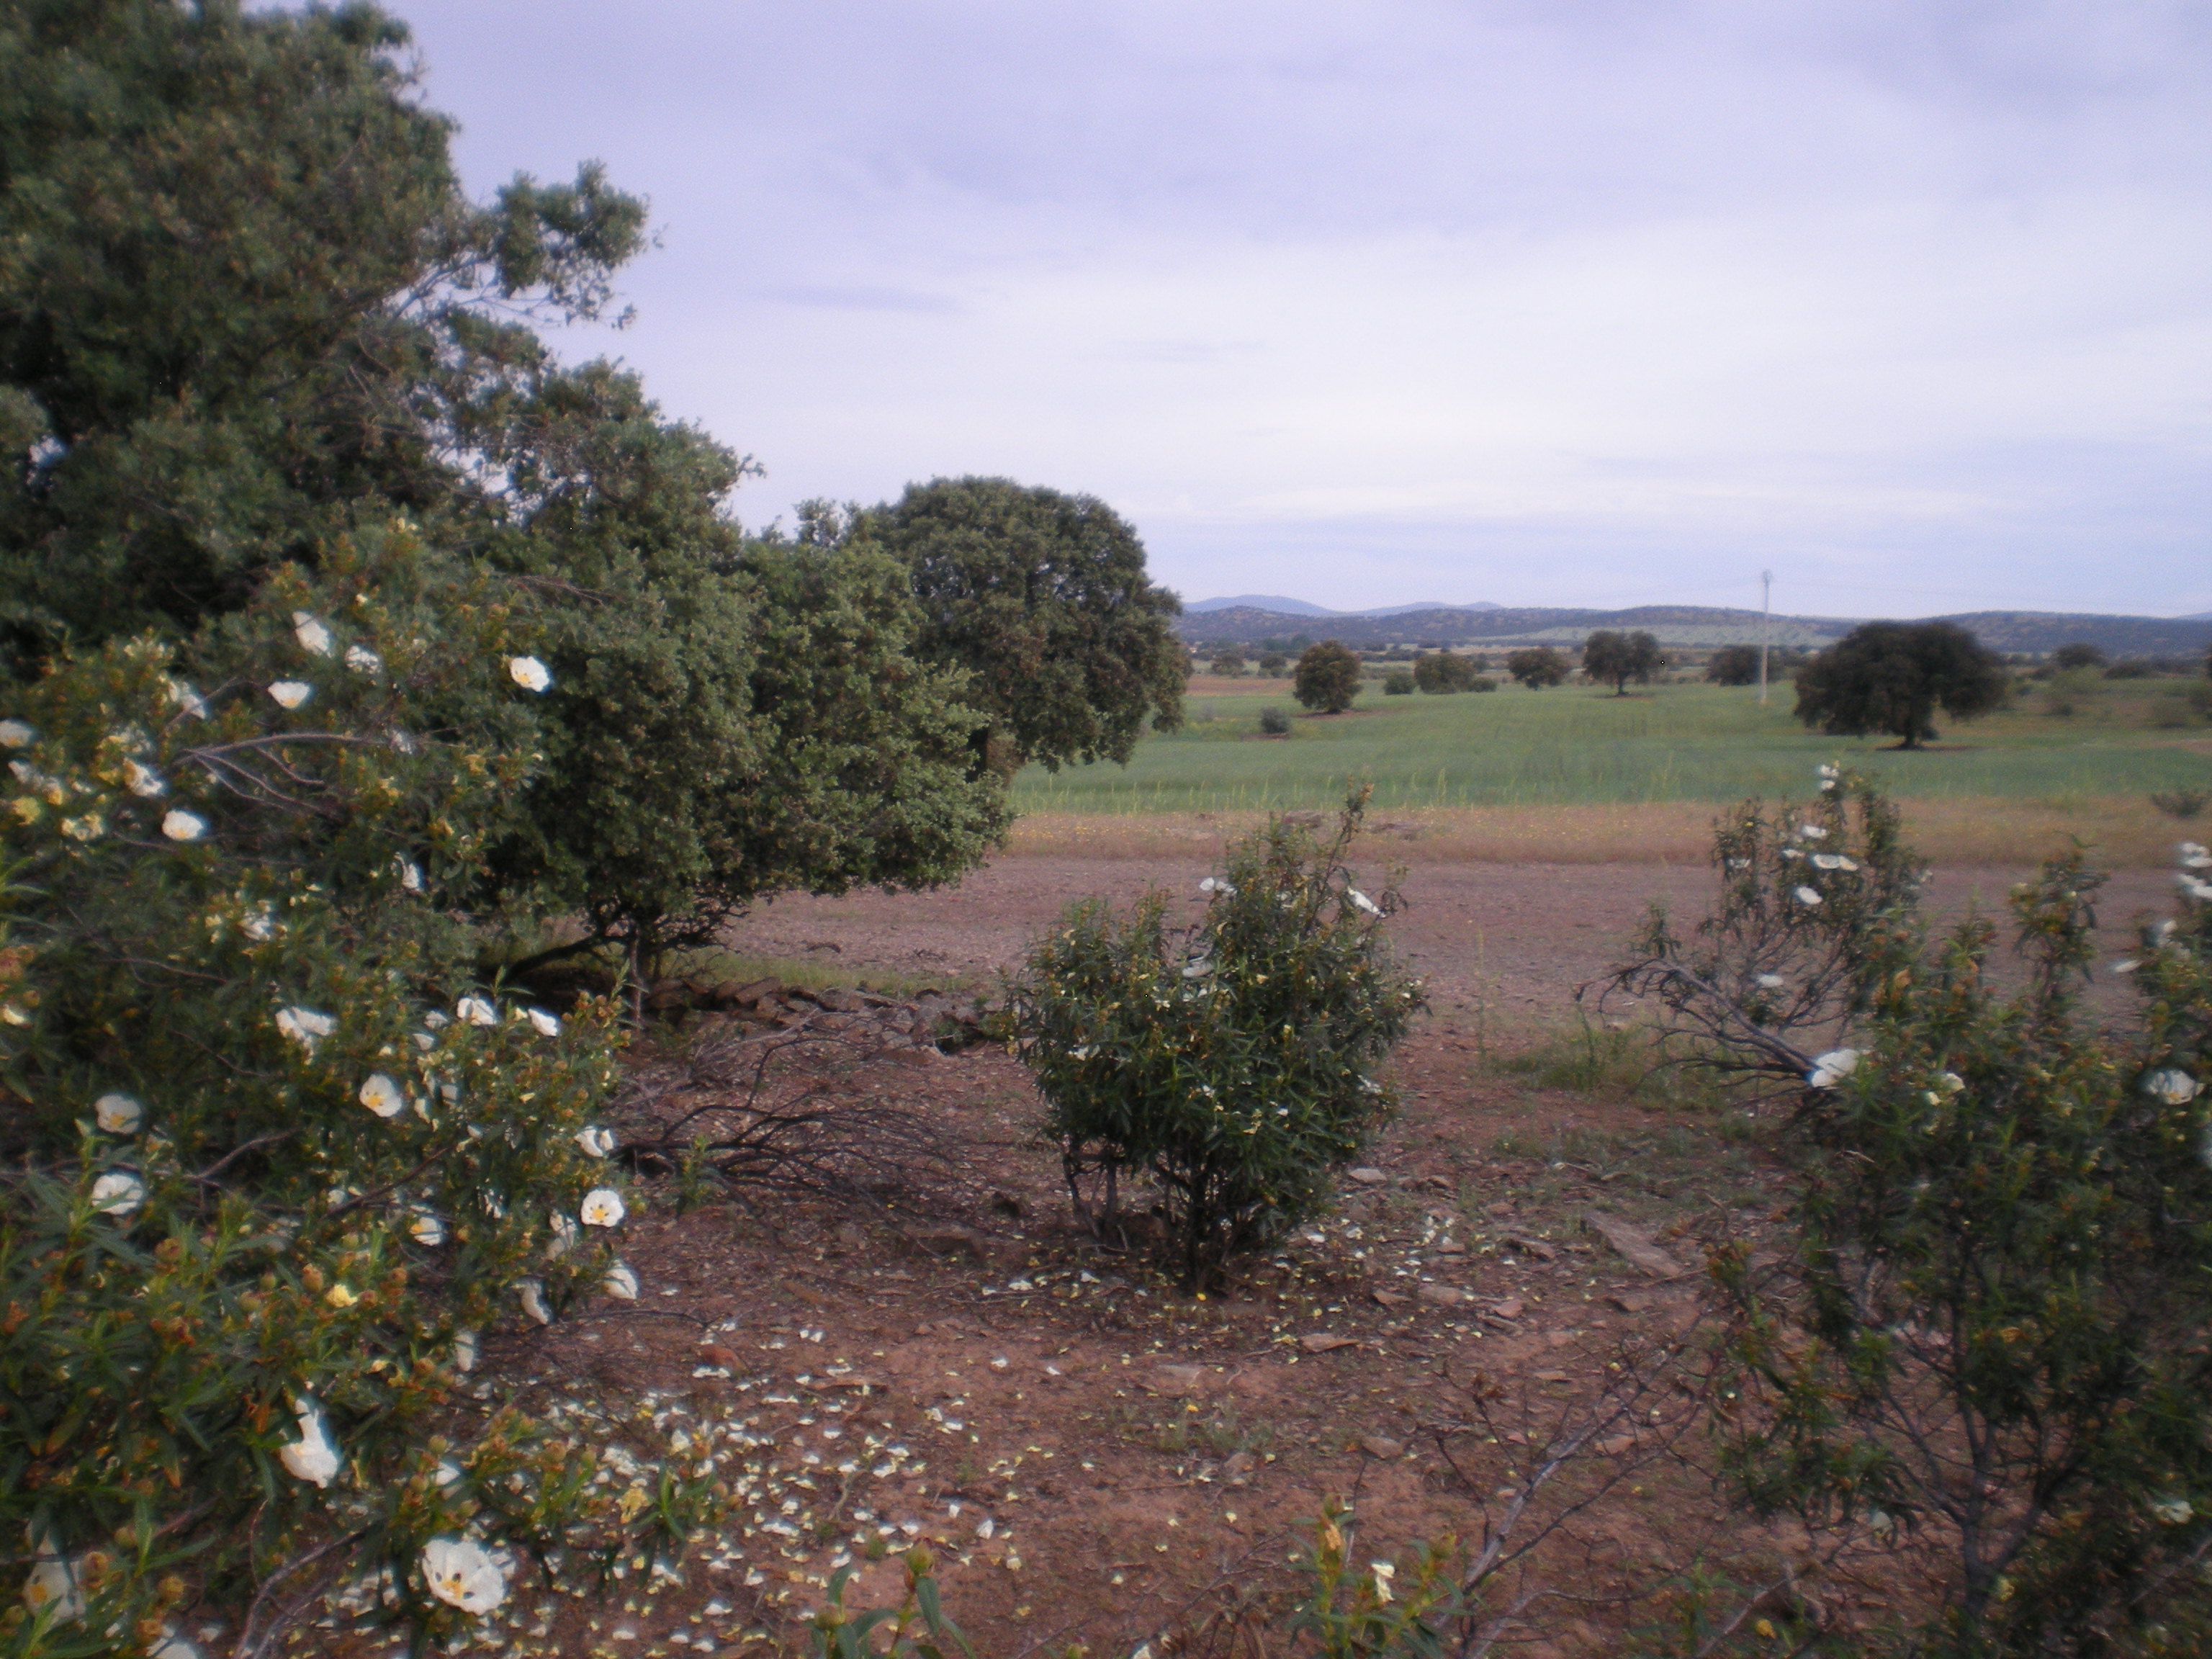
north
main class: Cropland
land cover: Oats
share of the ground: > 75 %
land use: Agriculture (excluding fallow land and kitchen gardens)
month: May
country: ES
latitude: 38.6553
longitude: -3.2110
